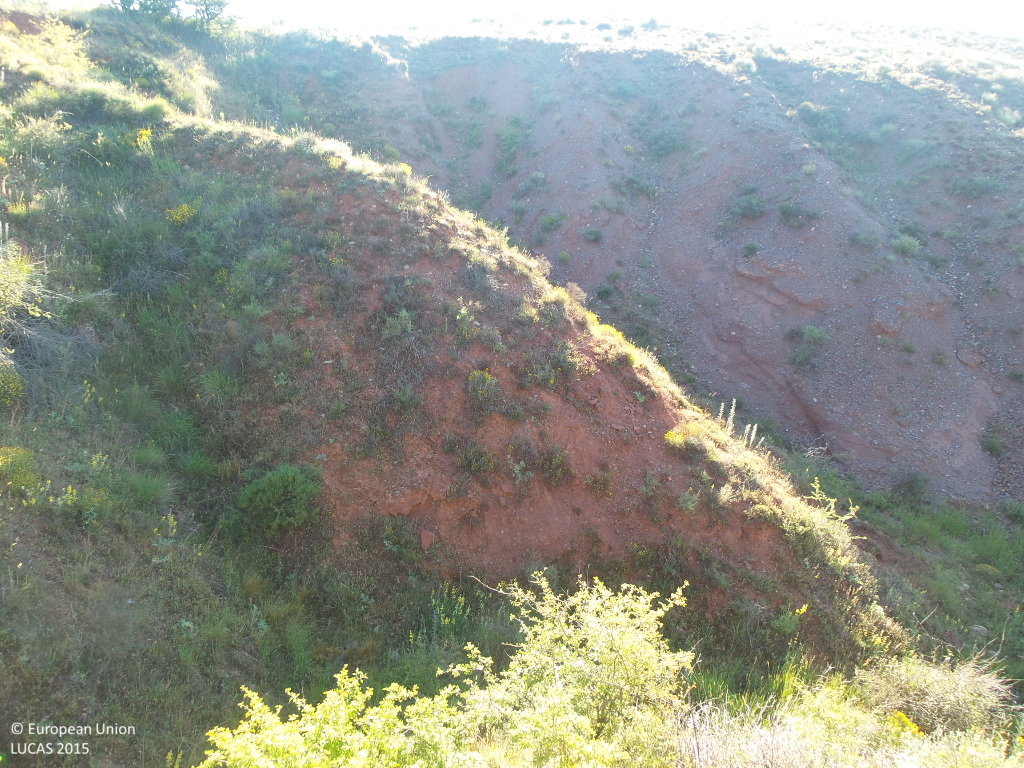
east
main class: Shrubland
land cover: Shrubland without tree cover
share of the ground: > 75 %
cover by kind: shrubs 80 %, herbaceous plants 10 %, unconsolidated bare surface 10 %
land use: Semi-natural and natural areas not in use
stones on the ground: < 10 %
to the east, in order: Shrubland without tree cover
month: June
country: ES
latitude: 41.2182
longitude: -2.9315
